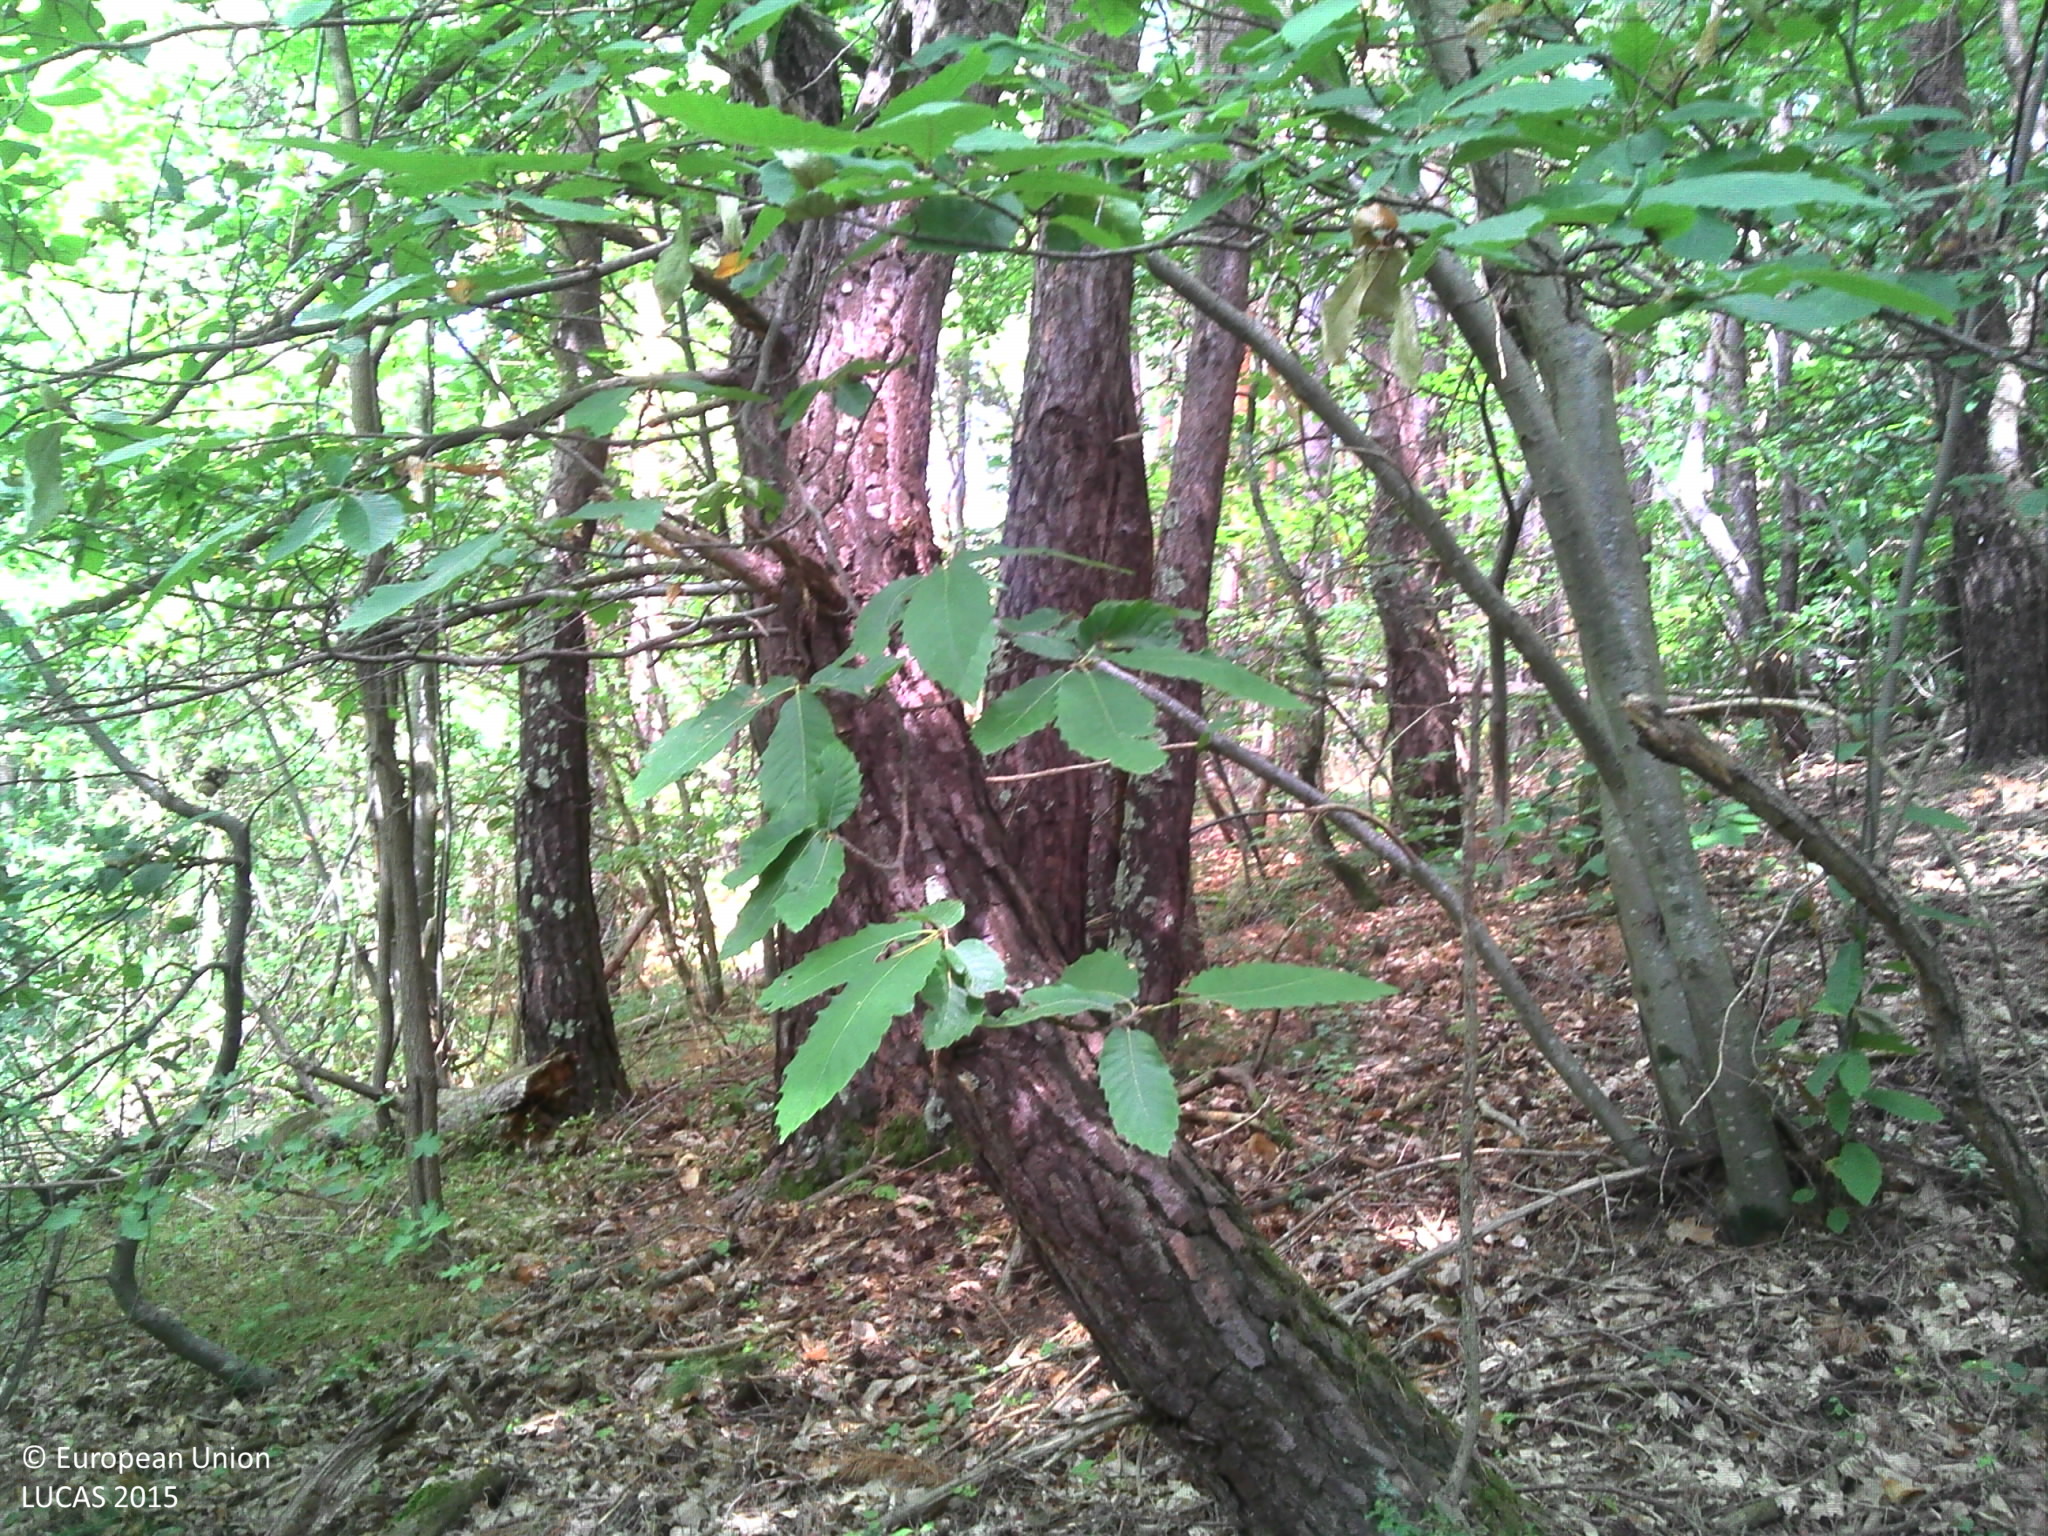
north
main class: Woodland
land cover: Pine dominated mixed woodland
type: hemiboreal forest and nemoral coniferous forest and mixed broadleaved-coniferous forest
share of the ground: > 75 %
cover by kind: broadleaved forest trees 40 %, coniferous forest trees 35 %, unconsolidated bare surface 15 %, herbaceous plants 10 %
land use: Semi-natural and natural areas not in use
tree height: > 5 m
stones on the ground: 10 - 25 %
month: August
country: FR
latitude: 44.8798
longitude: 4.6254
